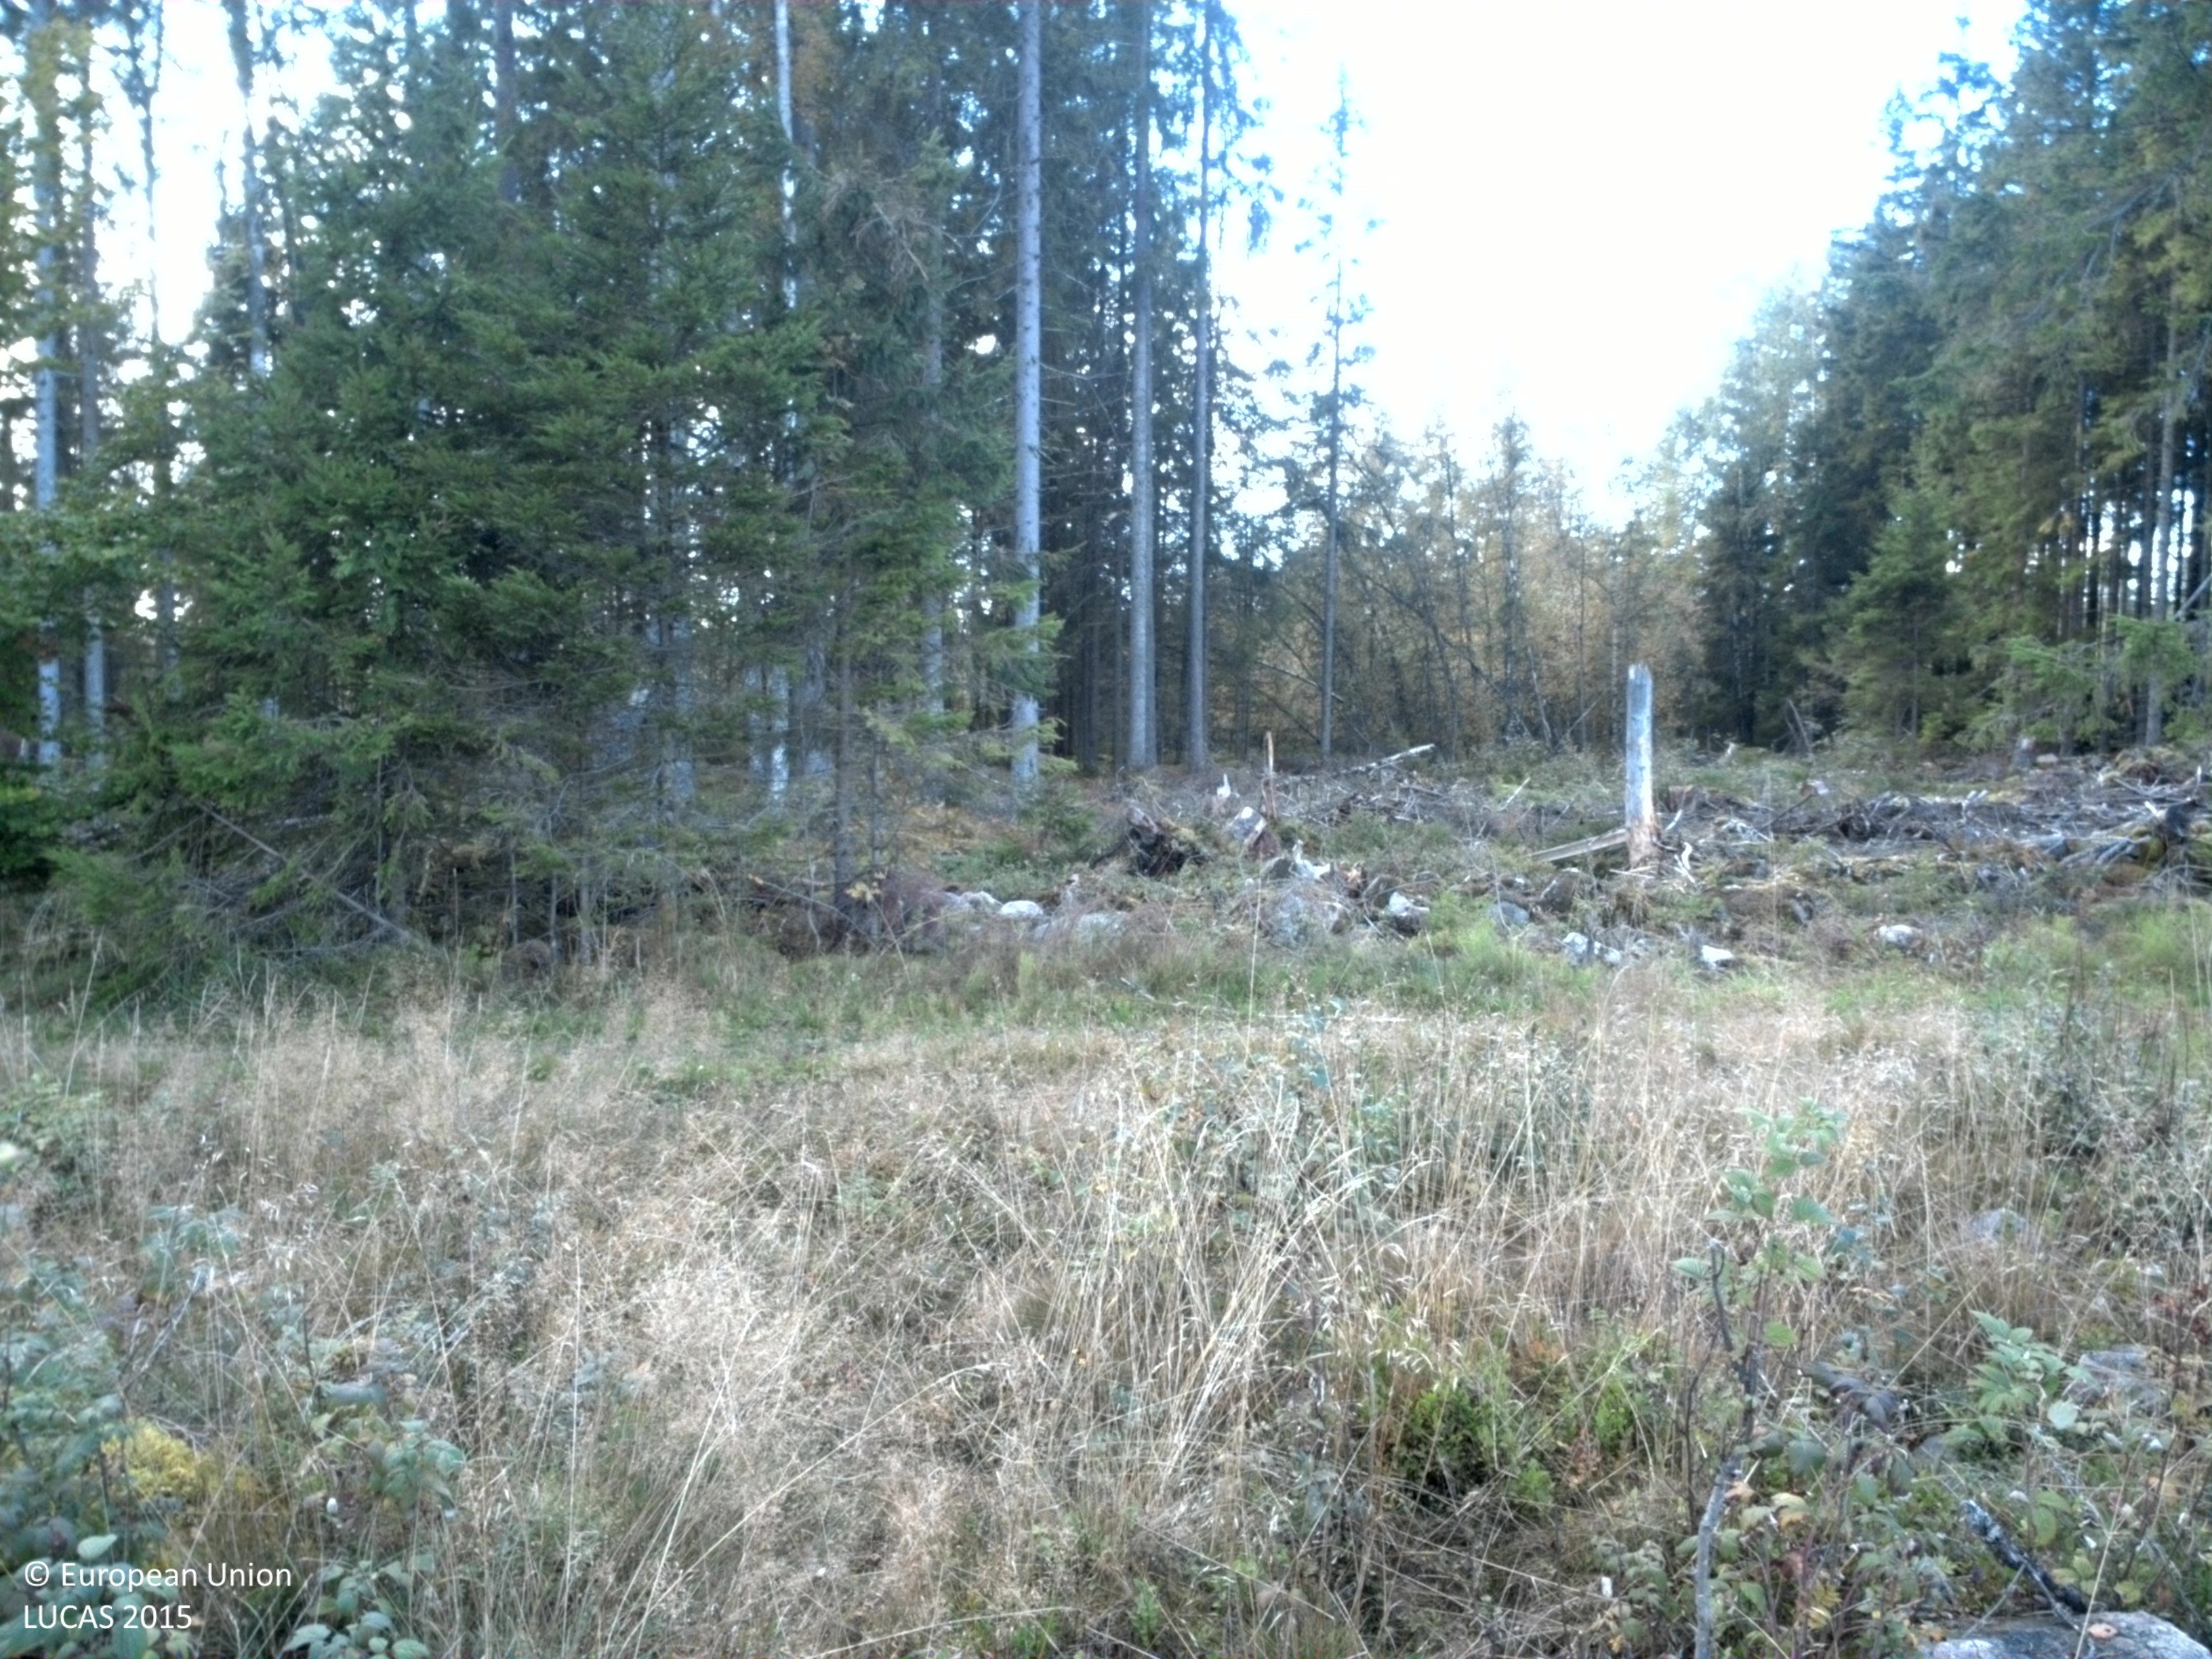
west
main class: Shrubland
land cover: Shrubland with sparse tree cover
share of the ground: 50 - 75 %
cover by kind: herbaceous plants 50 %, shrubs 45 %, broadleaved forest trees 5 %
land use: Forestry
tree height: < 5 m
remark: Clear cut
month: September
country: SE
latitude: 57.8775
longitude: 13.1146
